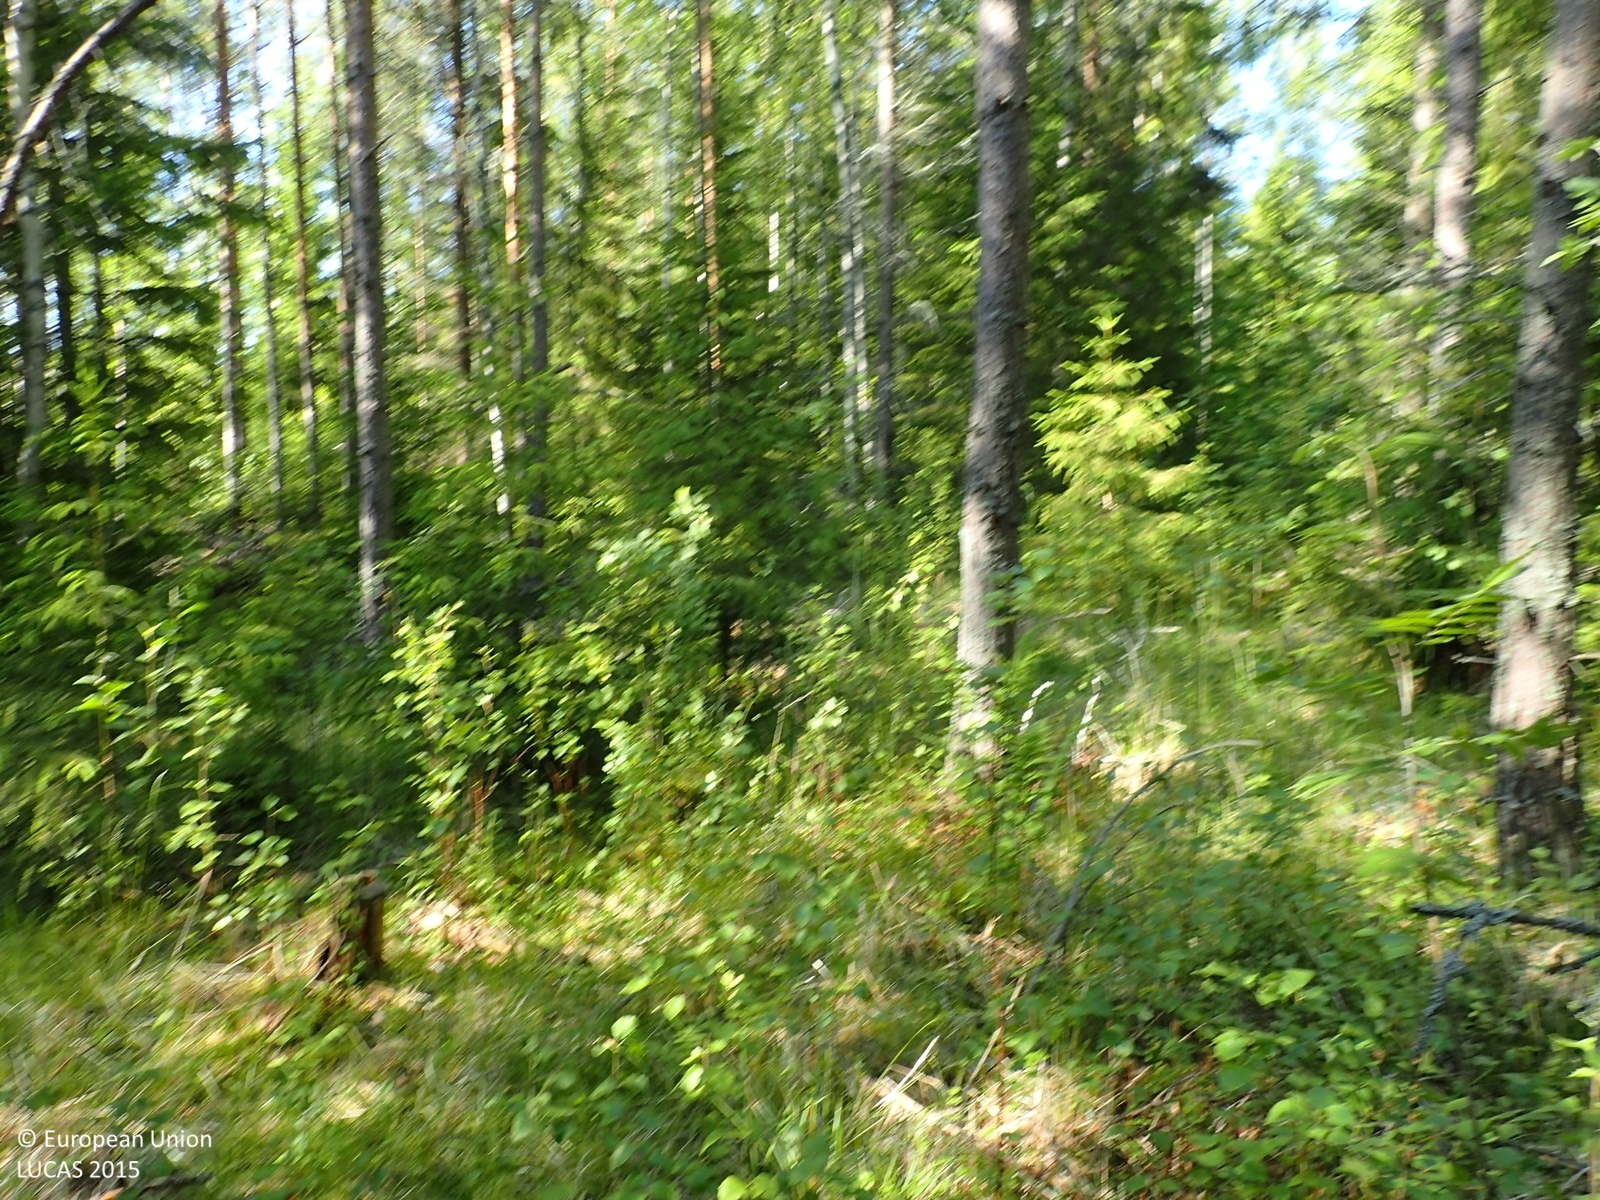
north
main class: Woodland
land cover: Other mixed woodland
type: boreal forest
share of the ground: > 75 %
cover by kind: coniferous forest trees 50 %, broadleaved forest trees 25 %, herbaceous plants 20 %, lichens and mosses 5 %
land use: Forestry
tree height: > 5 m
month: June
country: FI
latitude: 62.4442
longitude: 21.2601
